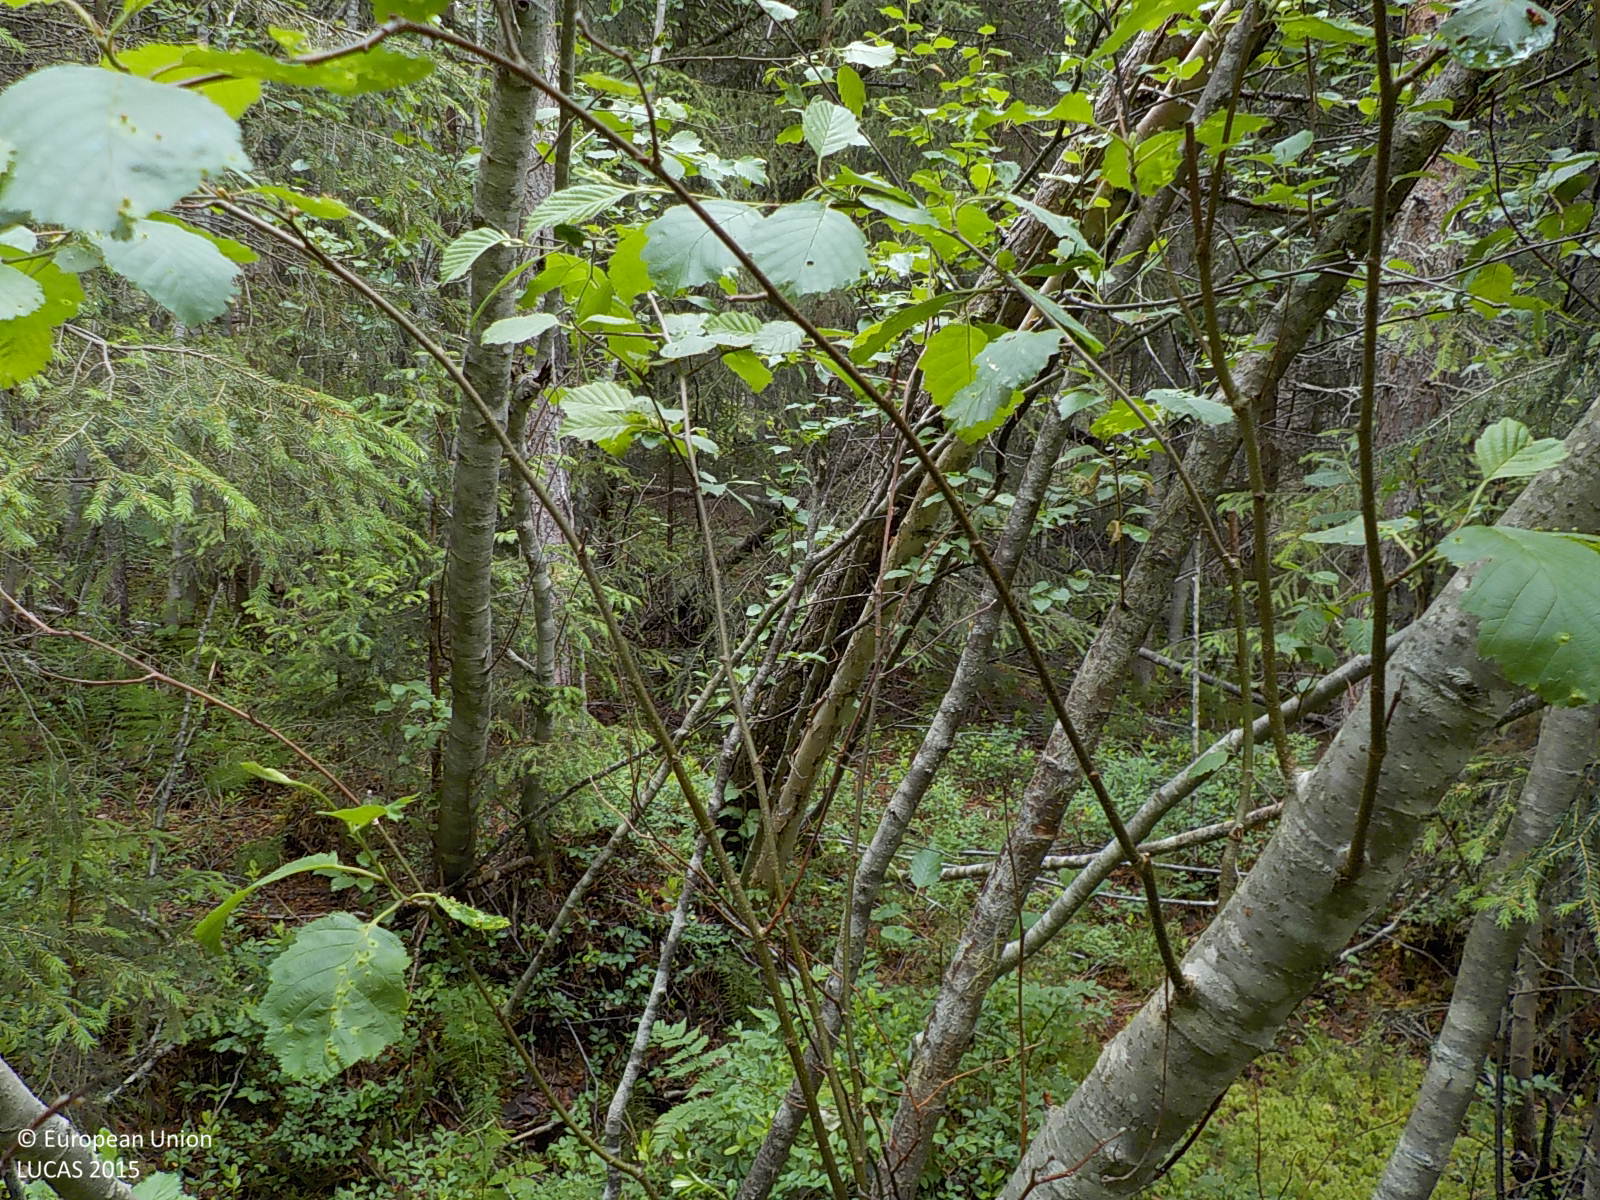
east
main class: Woodland
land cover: Spruce dominated mixed woodland
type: mire and swamp forests
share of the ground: > 75 %
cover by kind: coniferous forest trees 50 %, broadleaved forest trees 40 %, shrubs 10 %
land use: Forestry
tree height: > 5 m
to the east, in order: Spruce dominated mixed woodland; Shrubland without tree cover; Pine dominated mixed woodland; Spruce dominated mixed woodland; Pine dominated mixed woodland; Spruce dominated mixed woodland
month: July
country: SE
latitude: 63.0869
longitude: 16.9268
